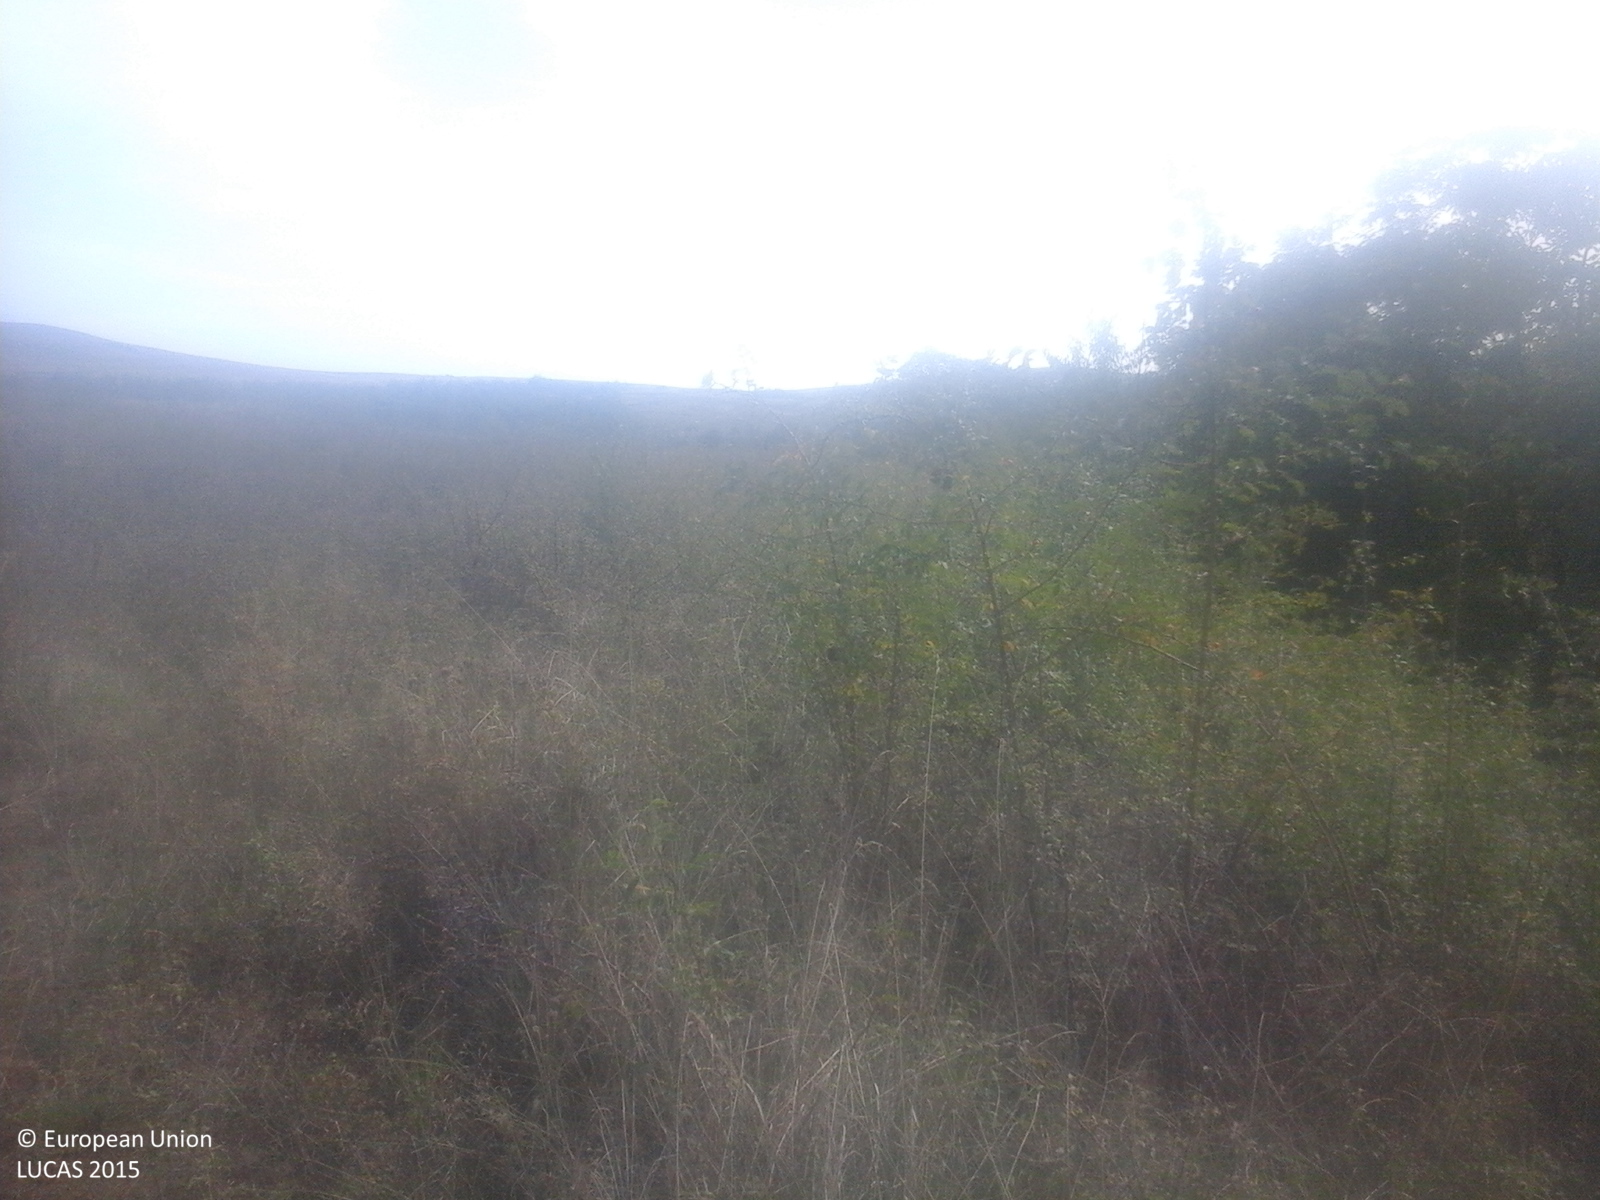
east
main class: Shrubland
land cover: Shrubland with sparse tree cover
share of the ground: > 75 %
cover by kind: herbaceous plants 65 %, shrubs 30 %, broadleaved forest trees 5 %
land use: Semi-natural and natural areas not in use
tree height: < 5 m
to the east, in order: Shrubland with sparse tree cover; Ditches and canals; Shrubland with sparse tree cover; Grassland without tree/shrub cover; Abandoned hedges; Ditches and canals; Shrubland with sparse tree cover; Tracks; Grassland without tree/shrub cover
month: September
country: RO
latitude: 45.4981
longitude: 22.8607
